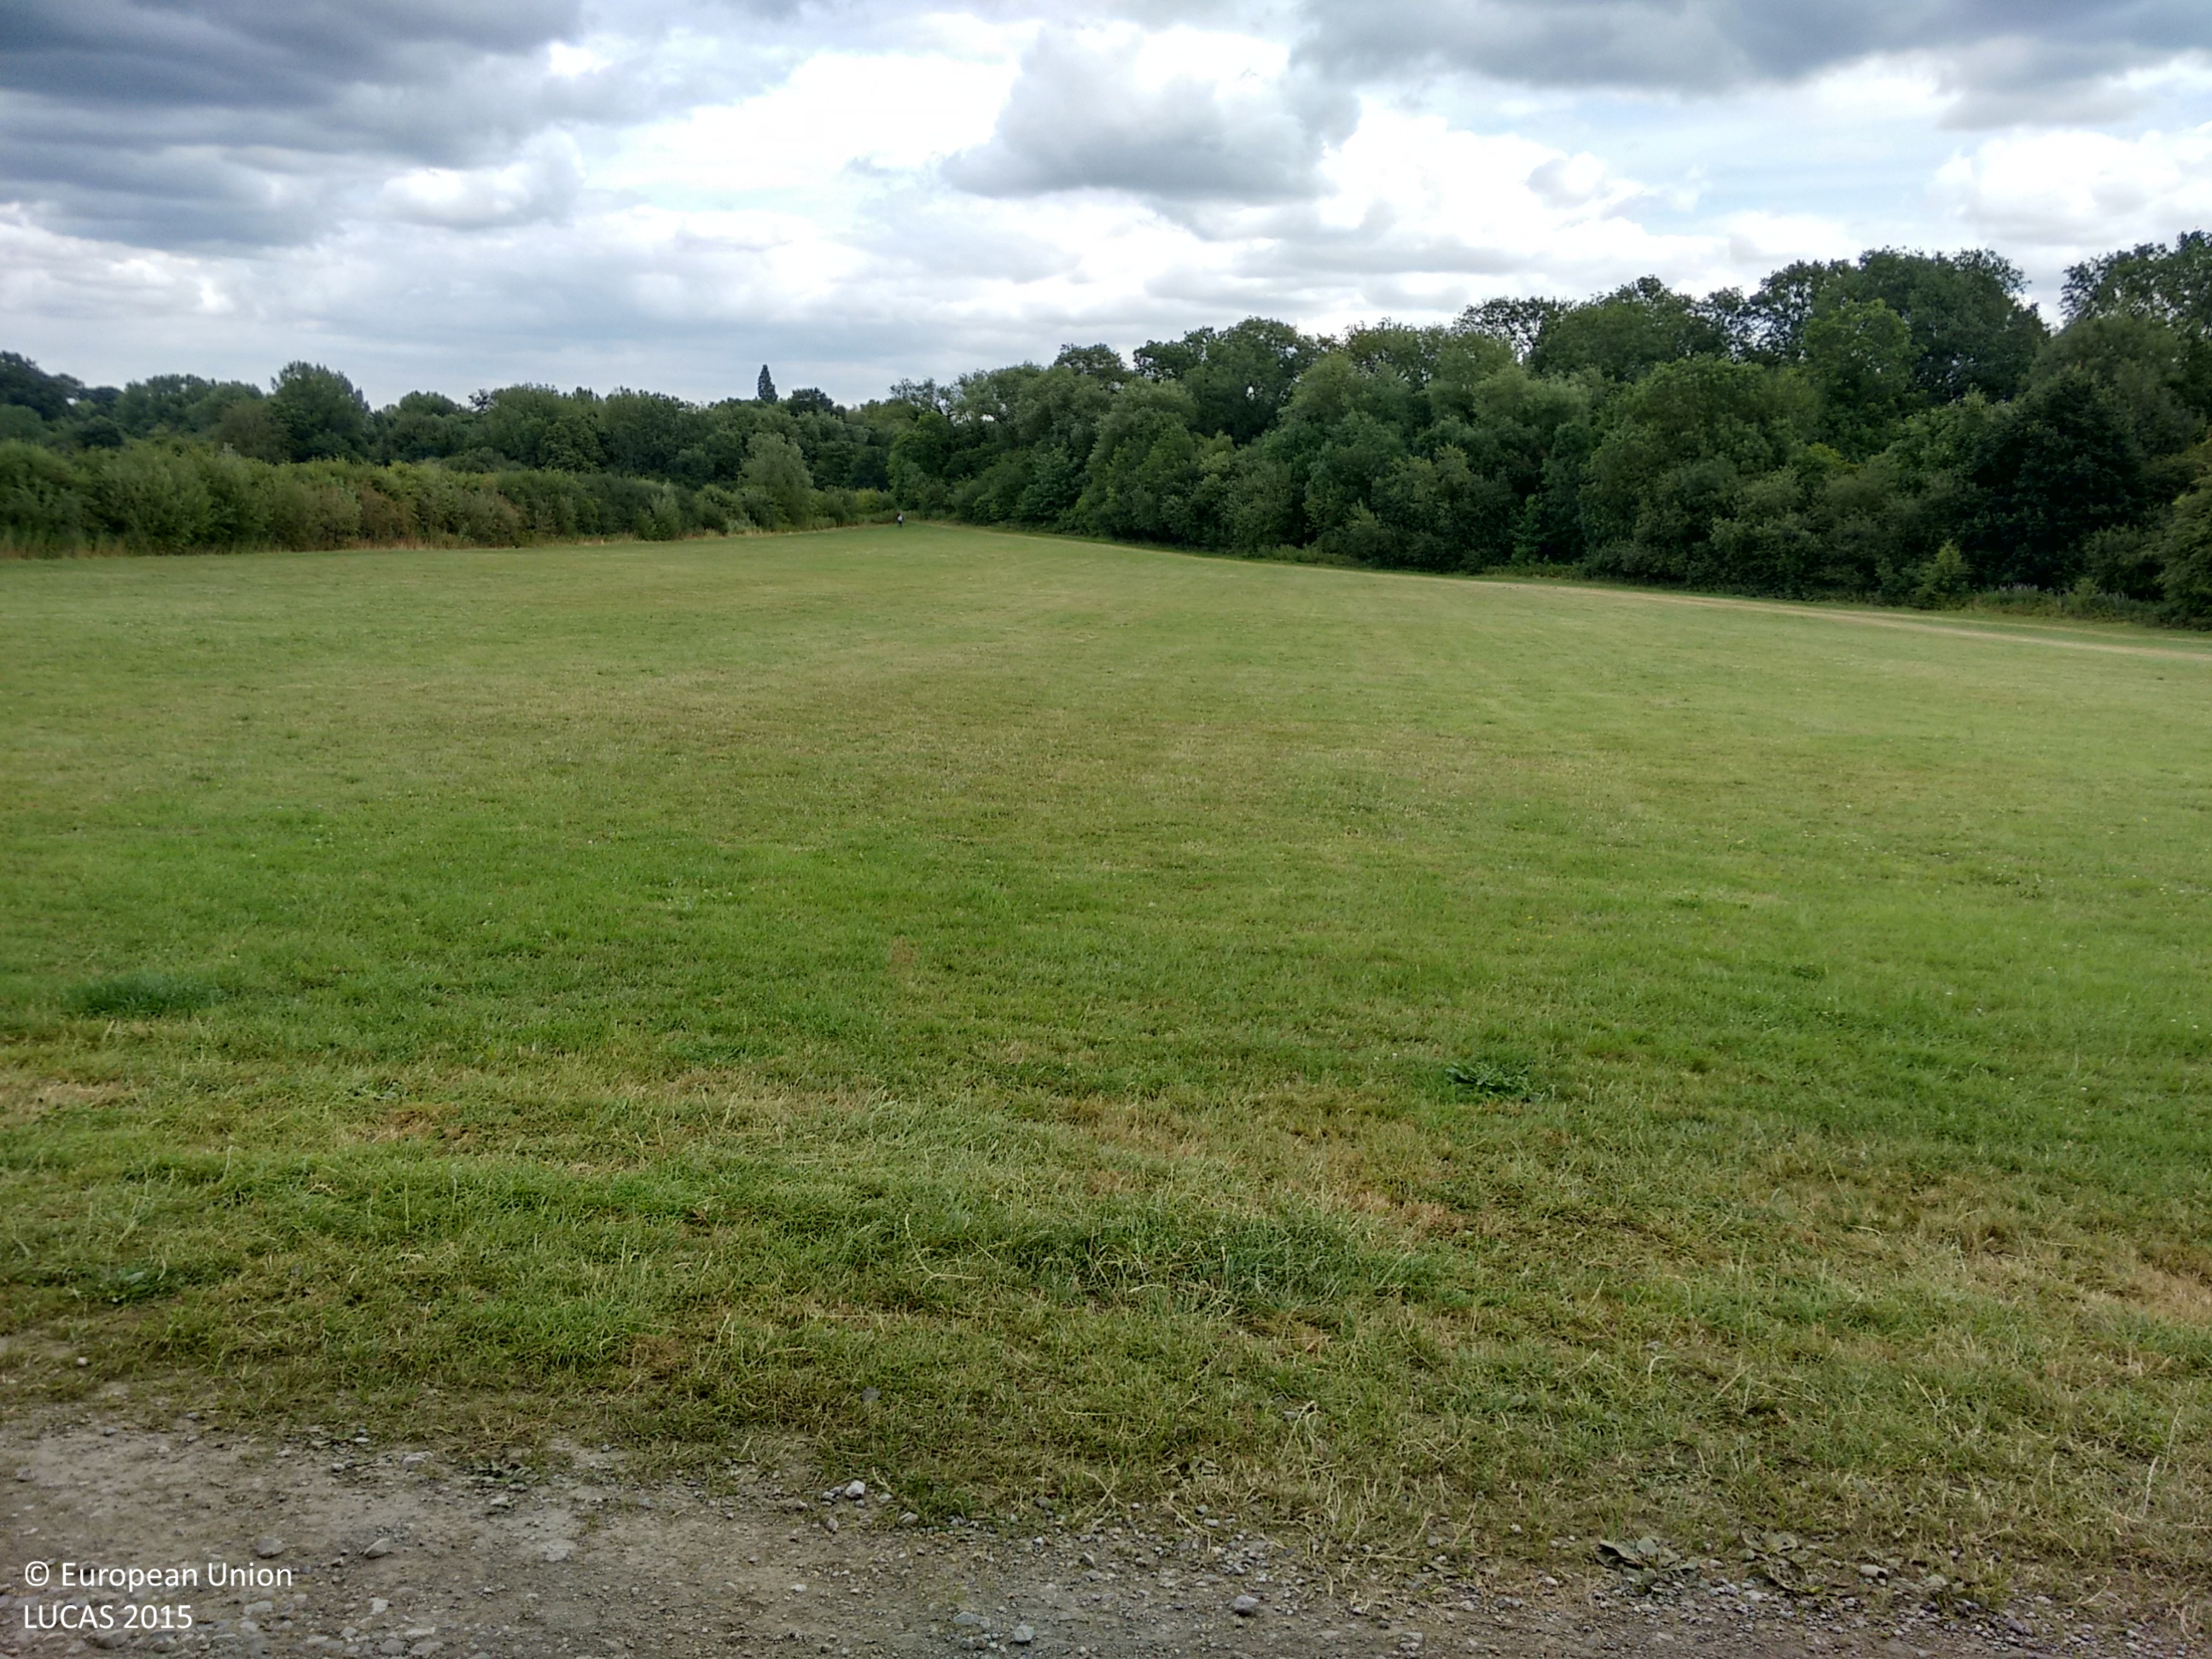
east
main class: Shrubland
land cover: Shrubland with sparse tree cover
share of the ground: > 75 %
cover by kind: shrubs 95 %, broadleaved forest trees 5 %
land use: Agriculture (excluding fallow land and kitchen gardens)
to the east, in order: Shrubland with sparse tree cover; Tracks; Grassland without tree/shrub cover; Broadleaved woodland
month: July
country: GB
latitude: 51.5510
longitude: -0.4648
